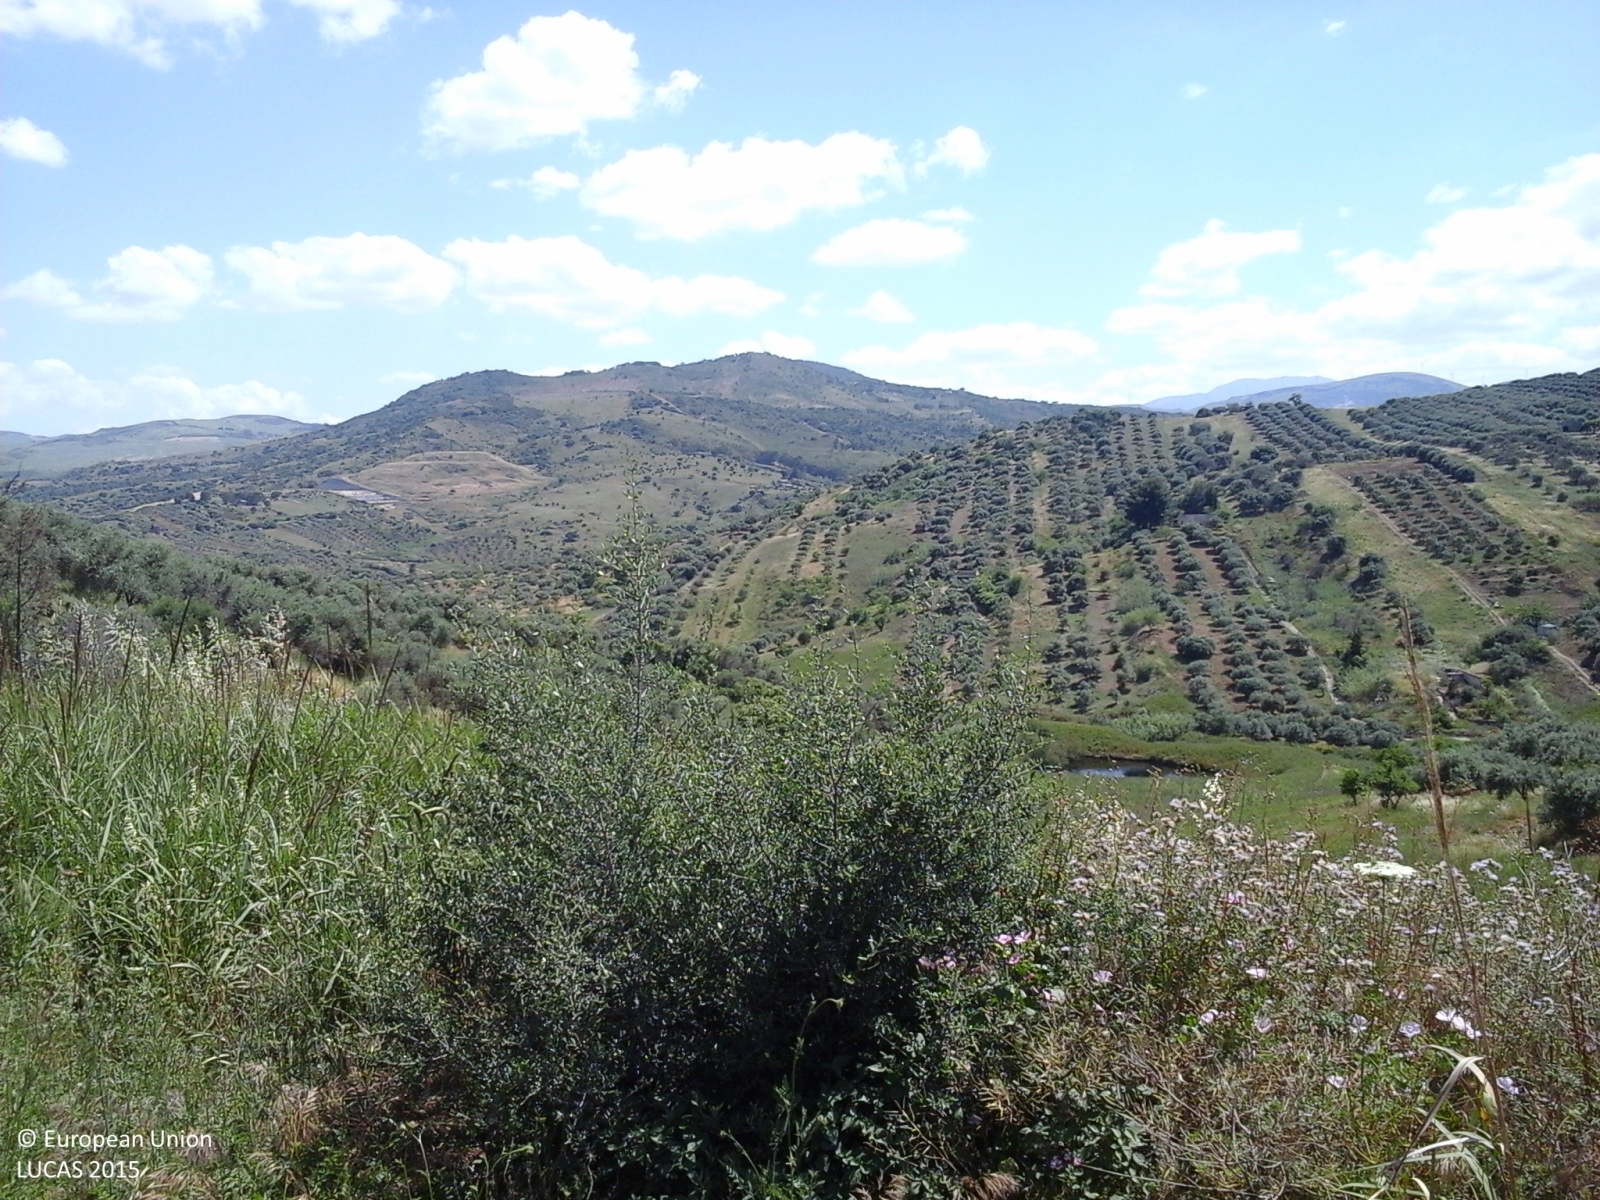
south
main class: Cropland
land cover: Olive groves
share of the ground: 25 - 50 %
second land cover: Spontaneously vegetated surfaces
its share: > 75 %
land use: Agriculture (excluding fallow land and kitchen gardens)
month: May
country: IT
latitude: 38.0103
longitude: 13.4947
